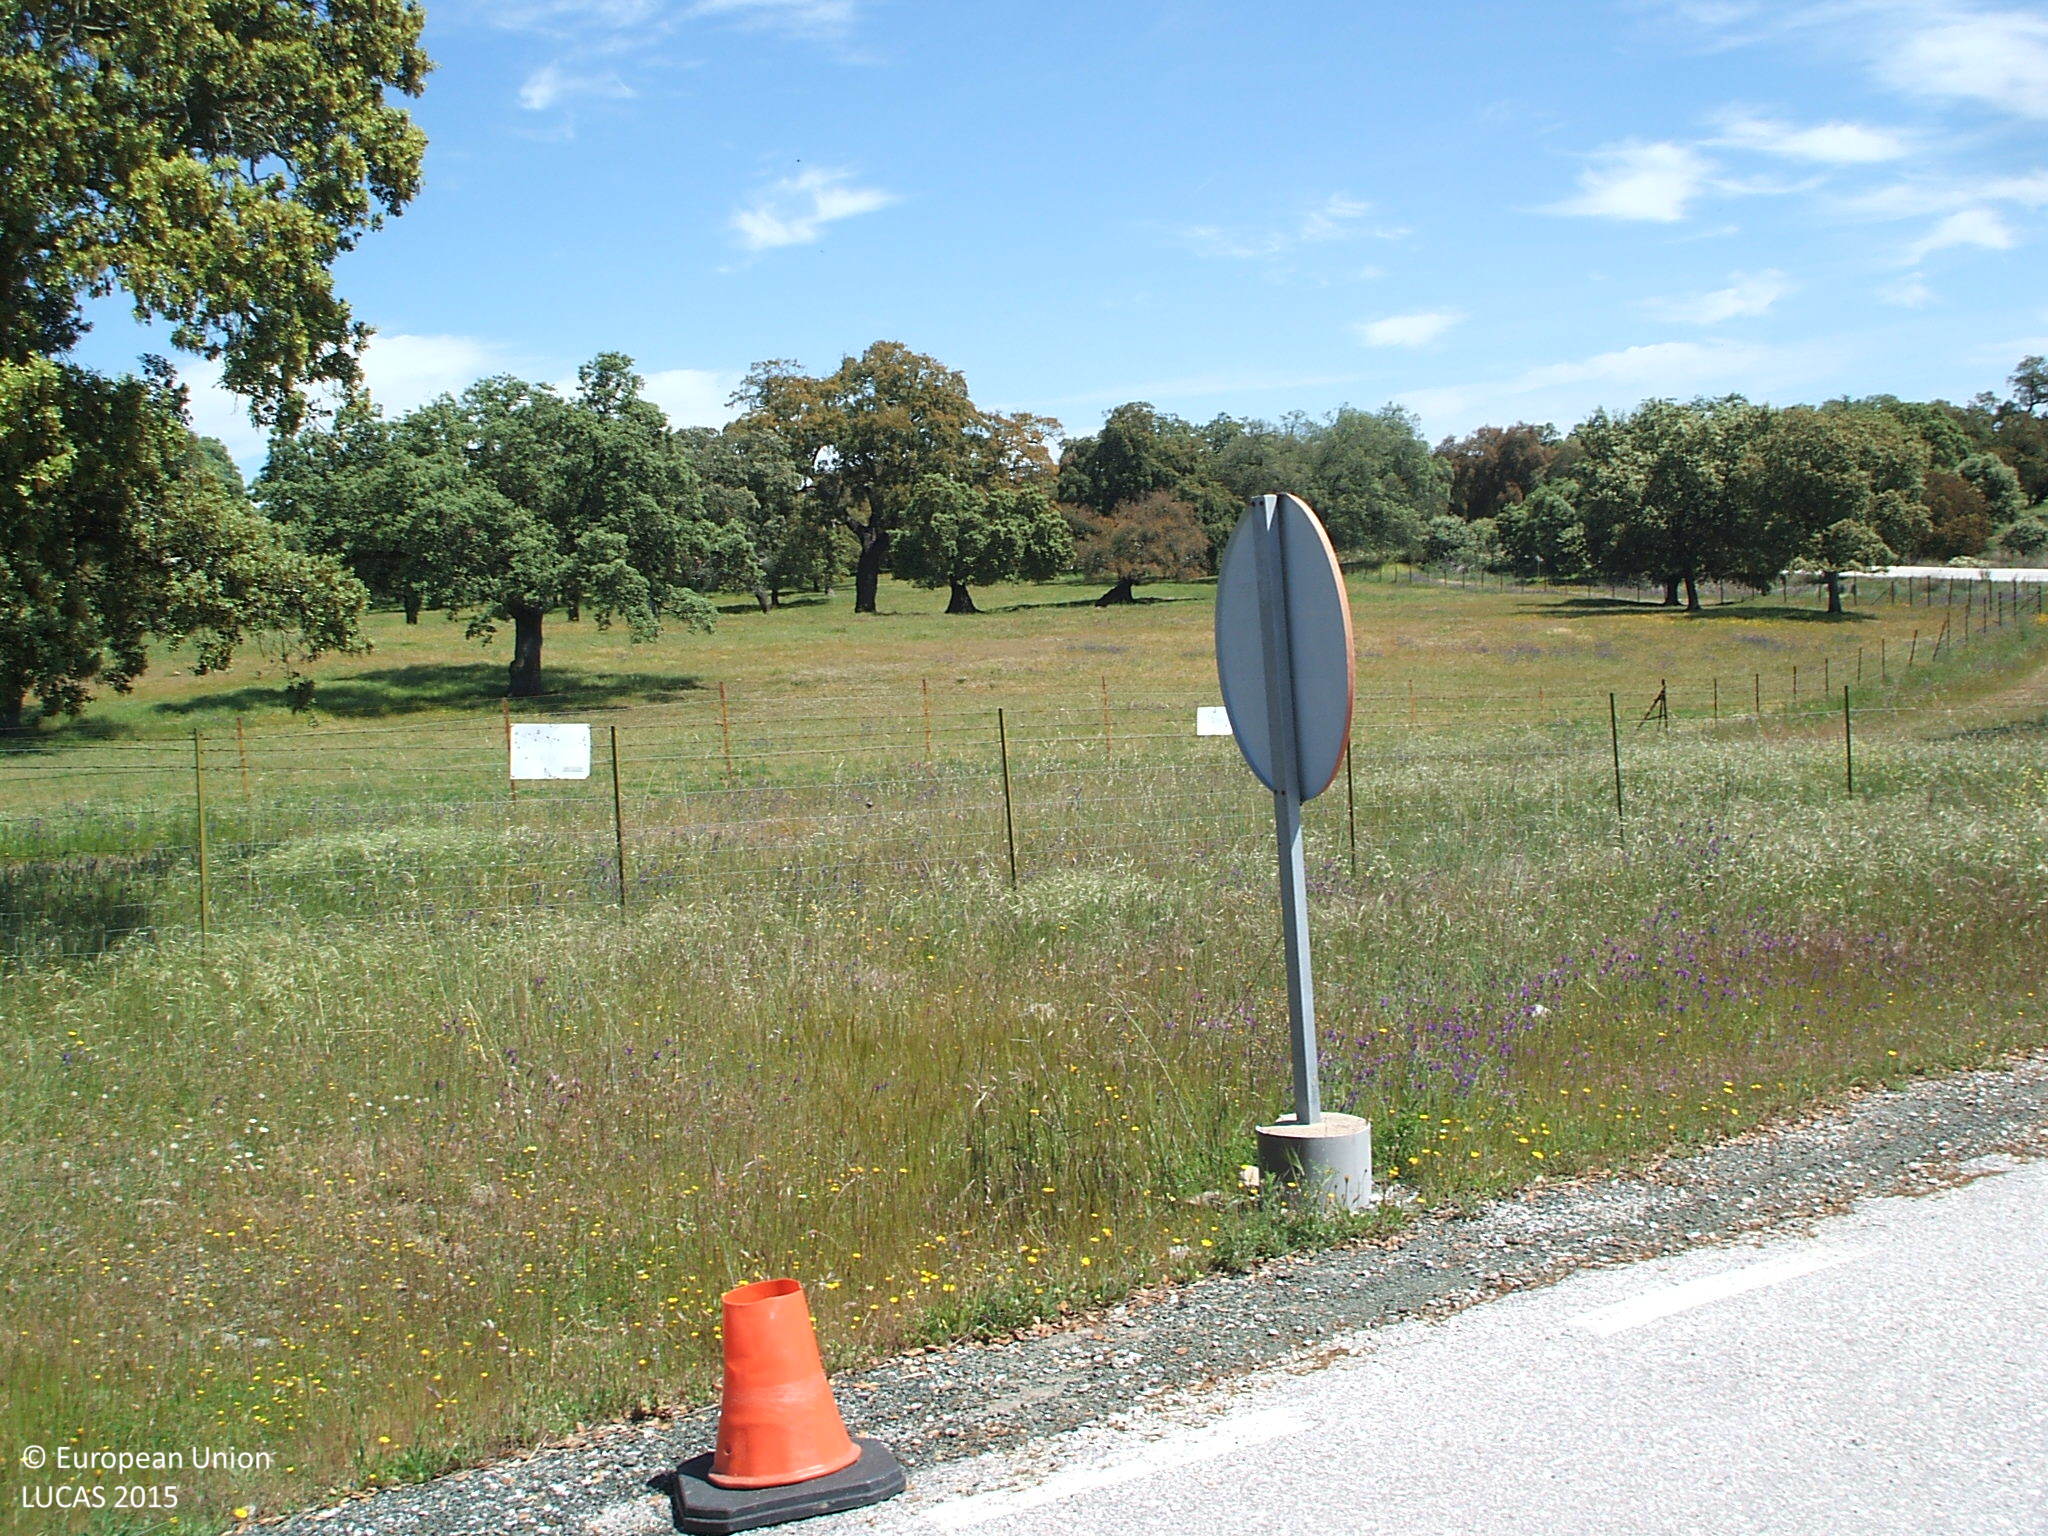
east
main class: Woodland
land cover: Broadleaved woodland
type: broadleaved evergreen forest
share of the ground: 25 - 50 %
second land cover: Grassland without tree/shrub cover
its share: > 75 %
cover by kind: herbaceous plants 60 %, broadleaved forest trees 40 %
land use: Forestry
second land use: Agriculture (excluding fallow land and kitchen gardens)
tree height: > 5 m
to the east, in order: Broadleaved woodland; Grassland without tree/shrub cover; Electric lines; Broadleaved woodland
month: April
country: ES
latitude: 37.7683
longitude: -5.6574
